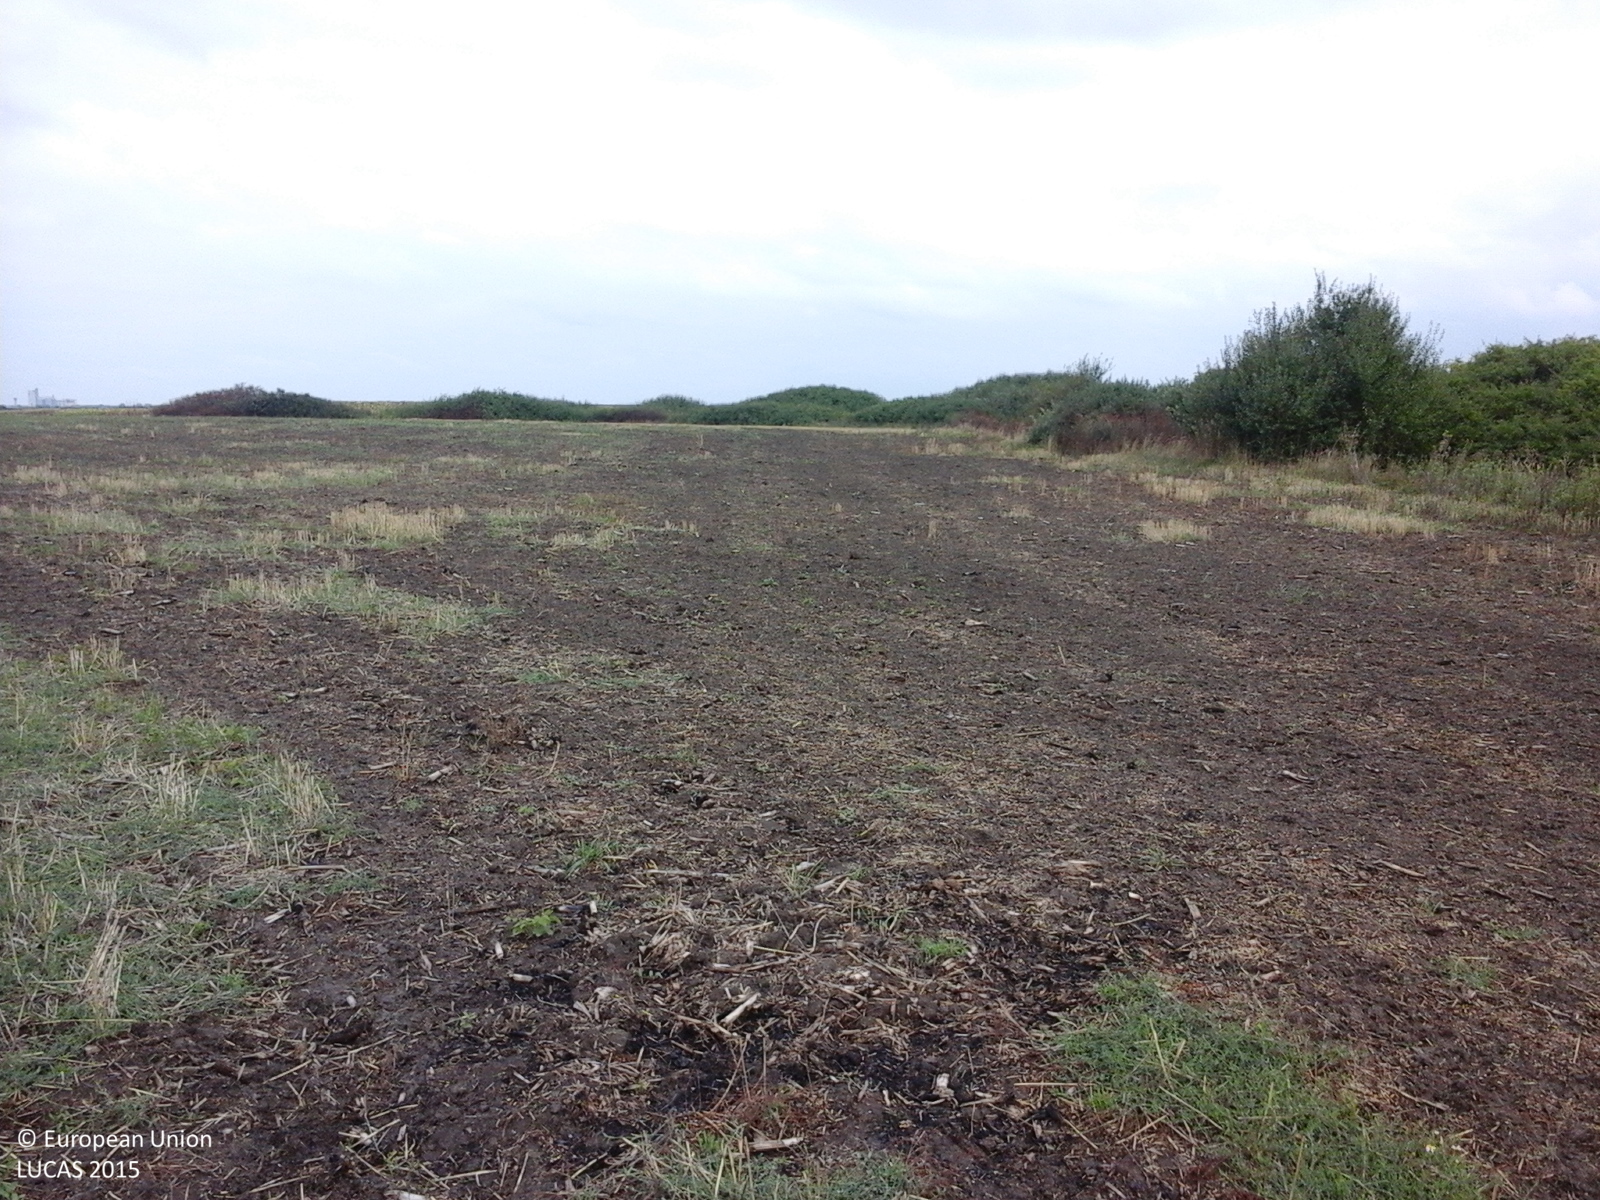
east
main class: Cropland
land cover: Common wheat
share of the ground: < 10 %
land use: Agriculture (excluding fallow land and kitchen gardens)
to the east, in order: Common wheat; Grass margins; Abandoned hedges; Ditches and canals; Abandoned hedges; Maize; Sunflower
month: August
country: RO
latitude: 45.5677
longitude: 21.1374
